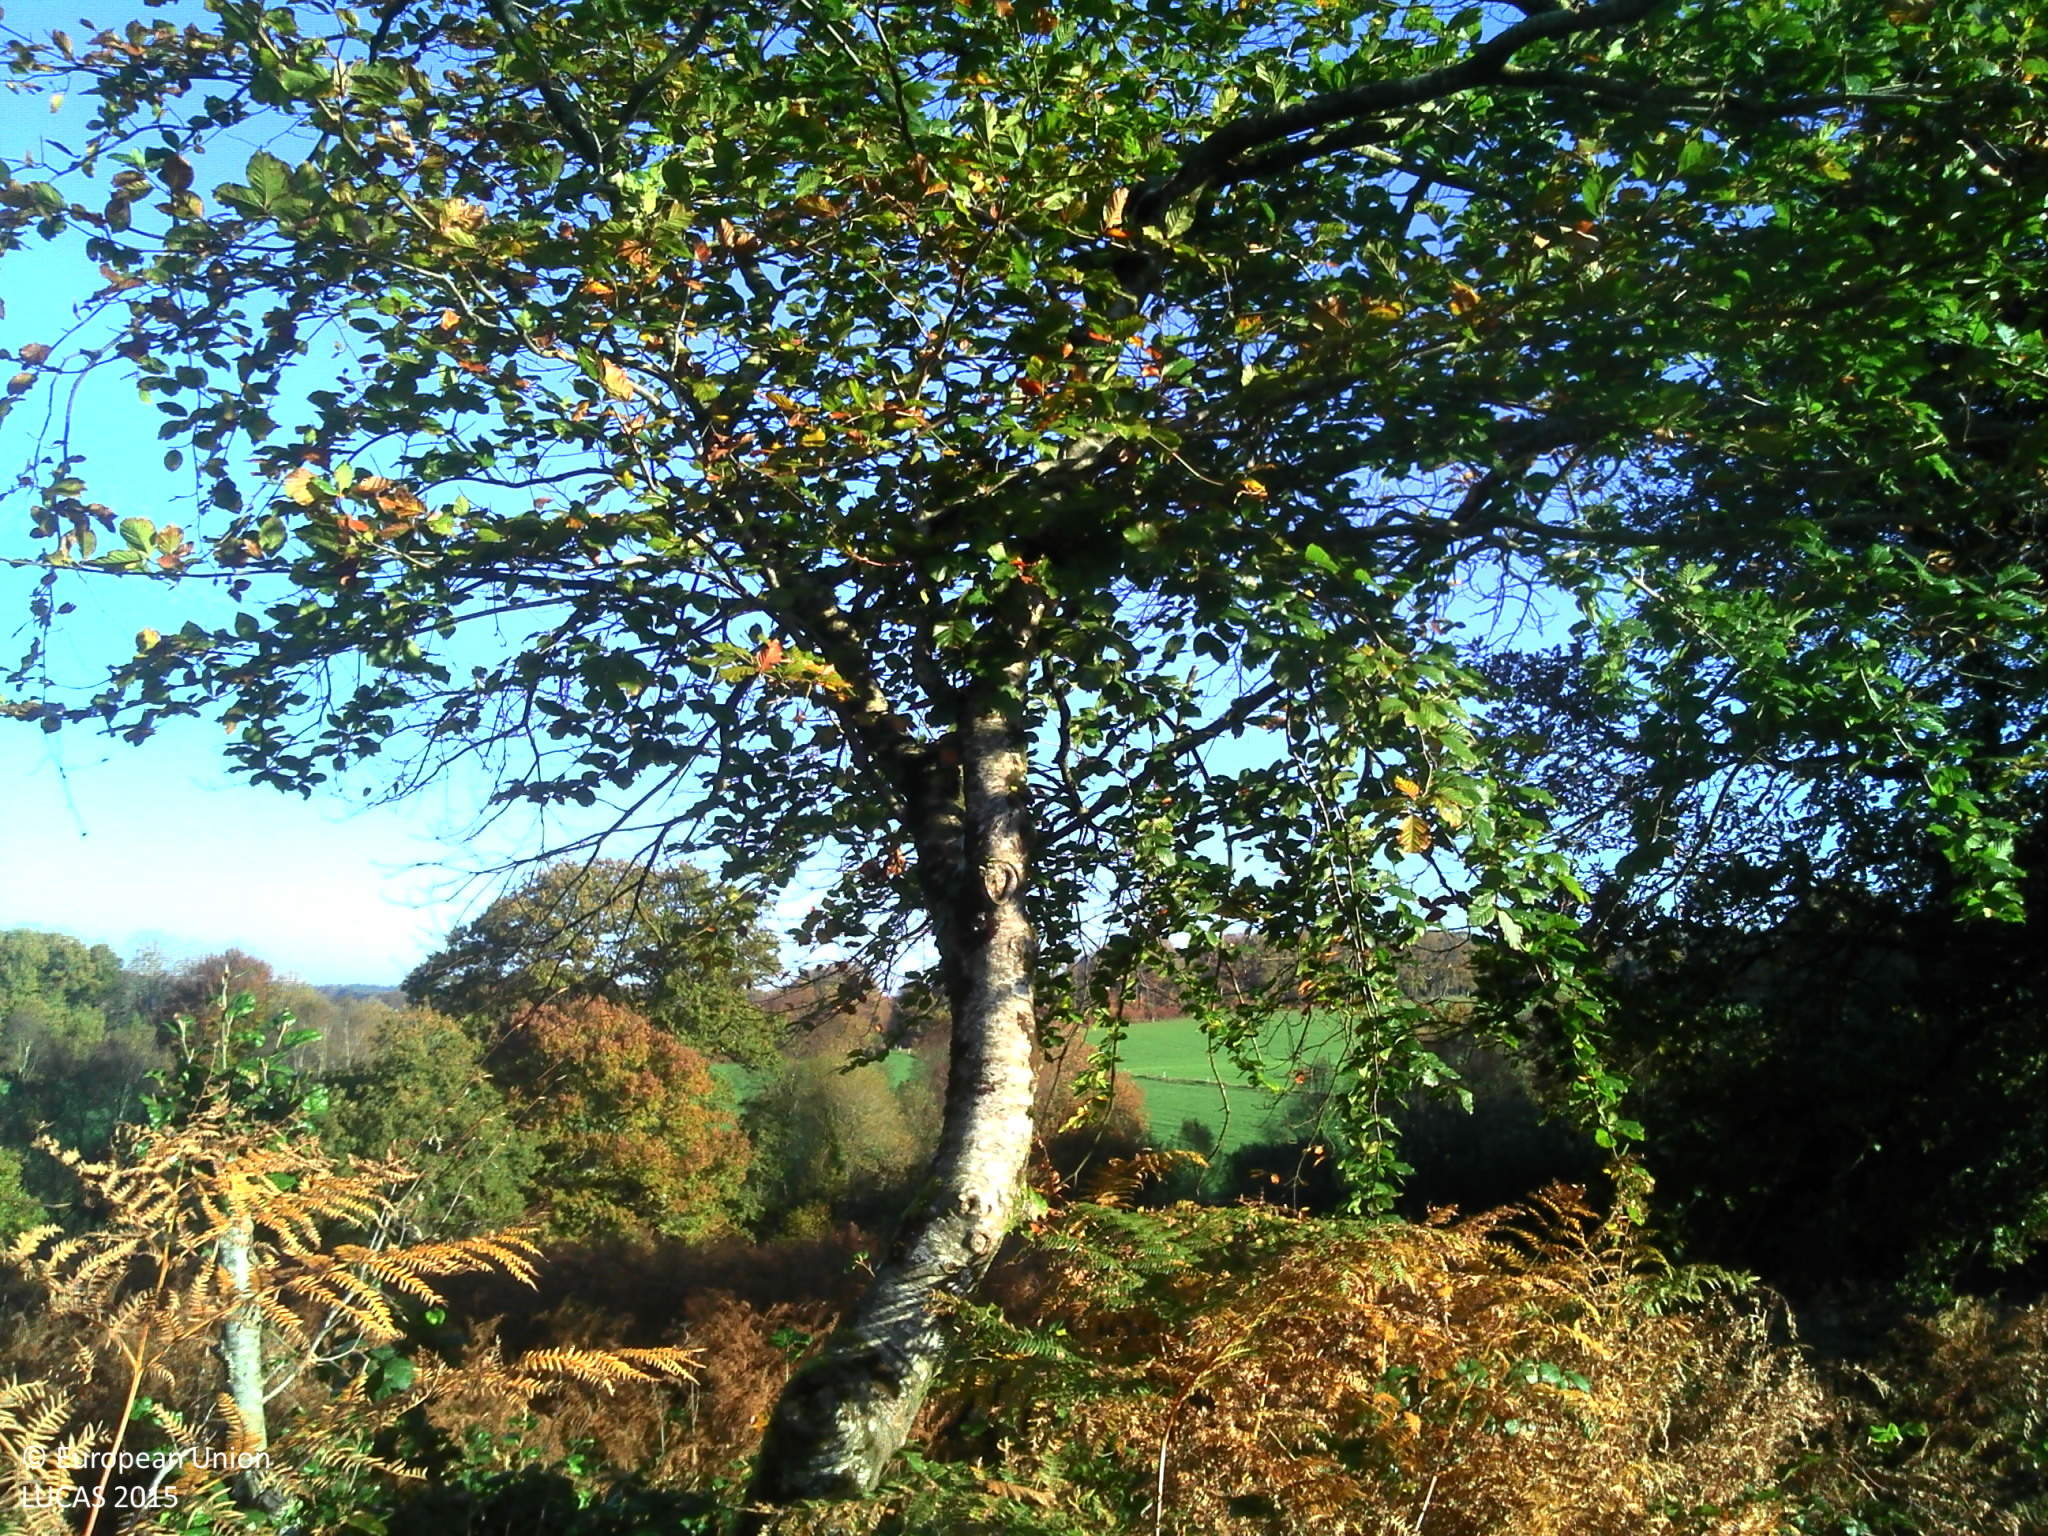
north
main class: Woodland
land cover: Broadleaved woodland
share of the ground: > 75 %
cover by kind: broadleaved forest trees 100 %
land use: Forestry
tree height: > 5 m
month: November
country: FR
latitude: 48.1091
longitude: -3.2757
